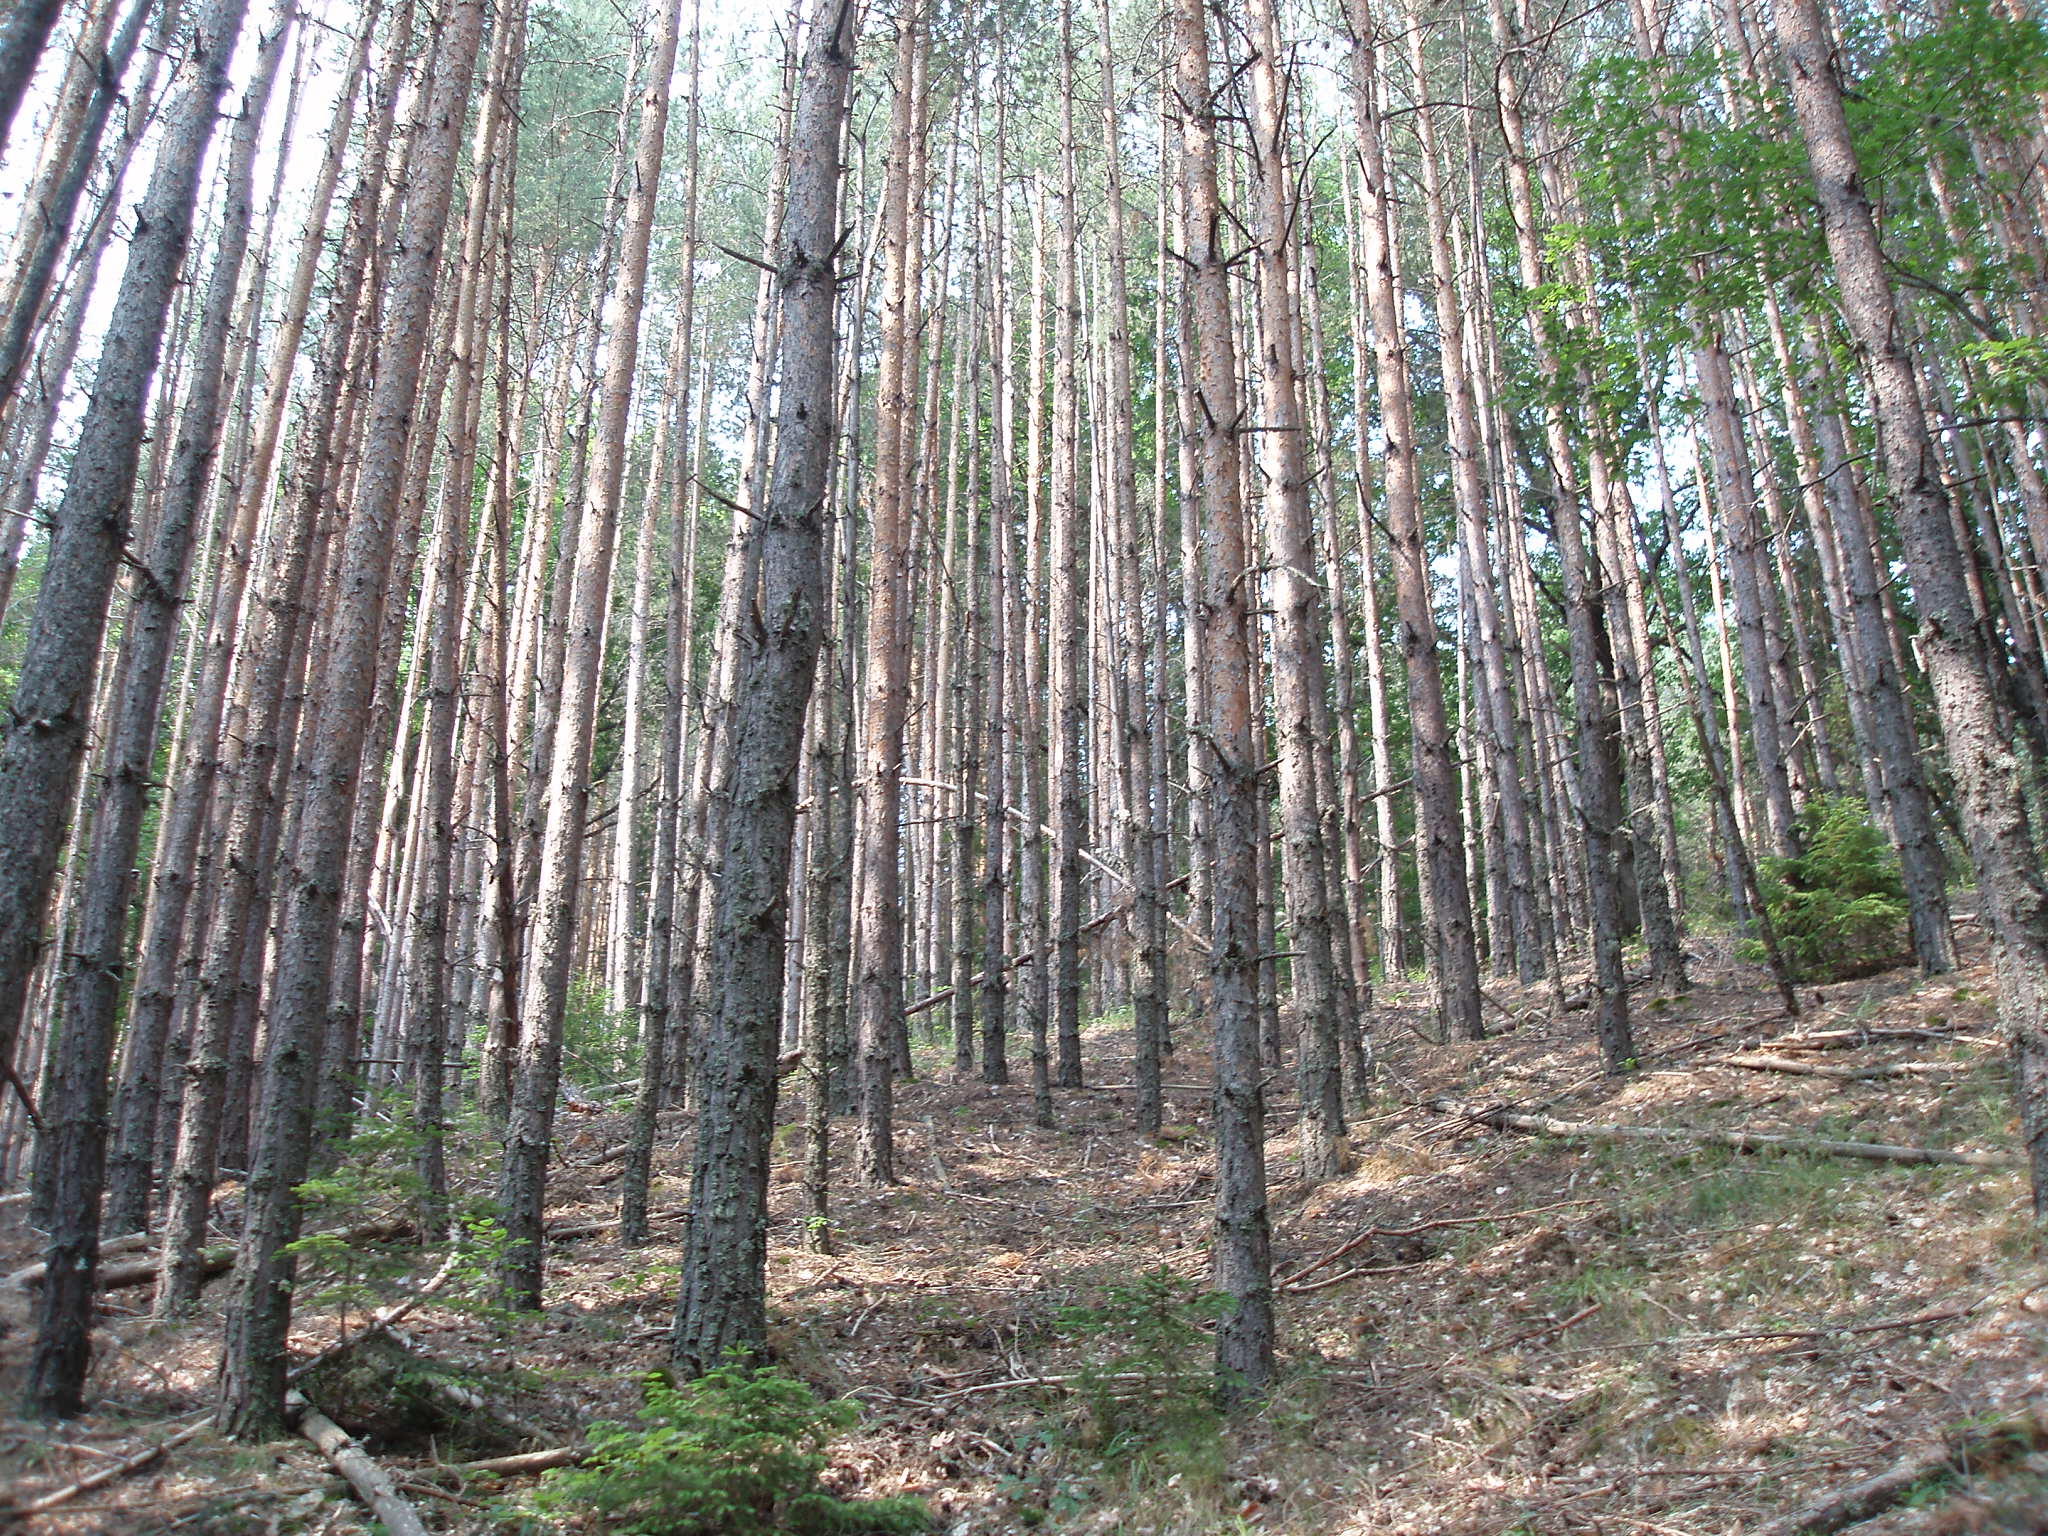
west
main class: Woodland
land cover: Pine dominated mixed woodland
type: hemiboreal forest and nemoral coniferous forest and mixed broadleaved-coniferous forest
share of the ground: > 75 %
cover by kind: coniferous forest trees 75 %, broadleaved forest trees 25 %
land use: Forestry
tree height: > 5 m
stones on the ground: > 50 %
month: July
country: BG
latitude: 42.0478
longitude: 23.6976
